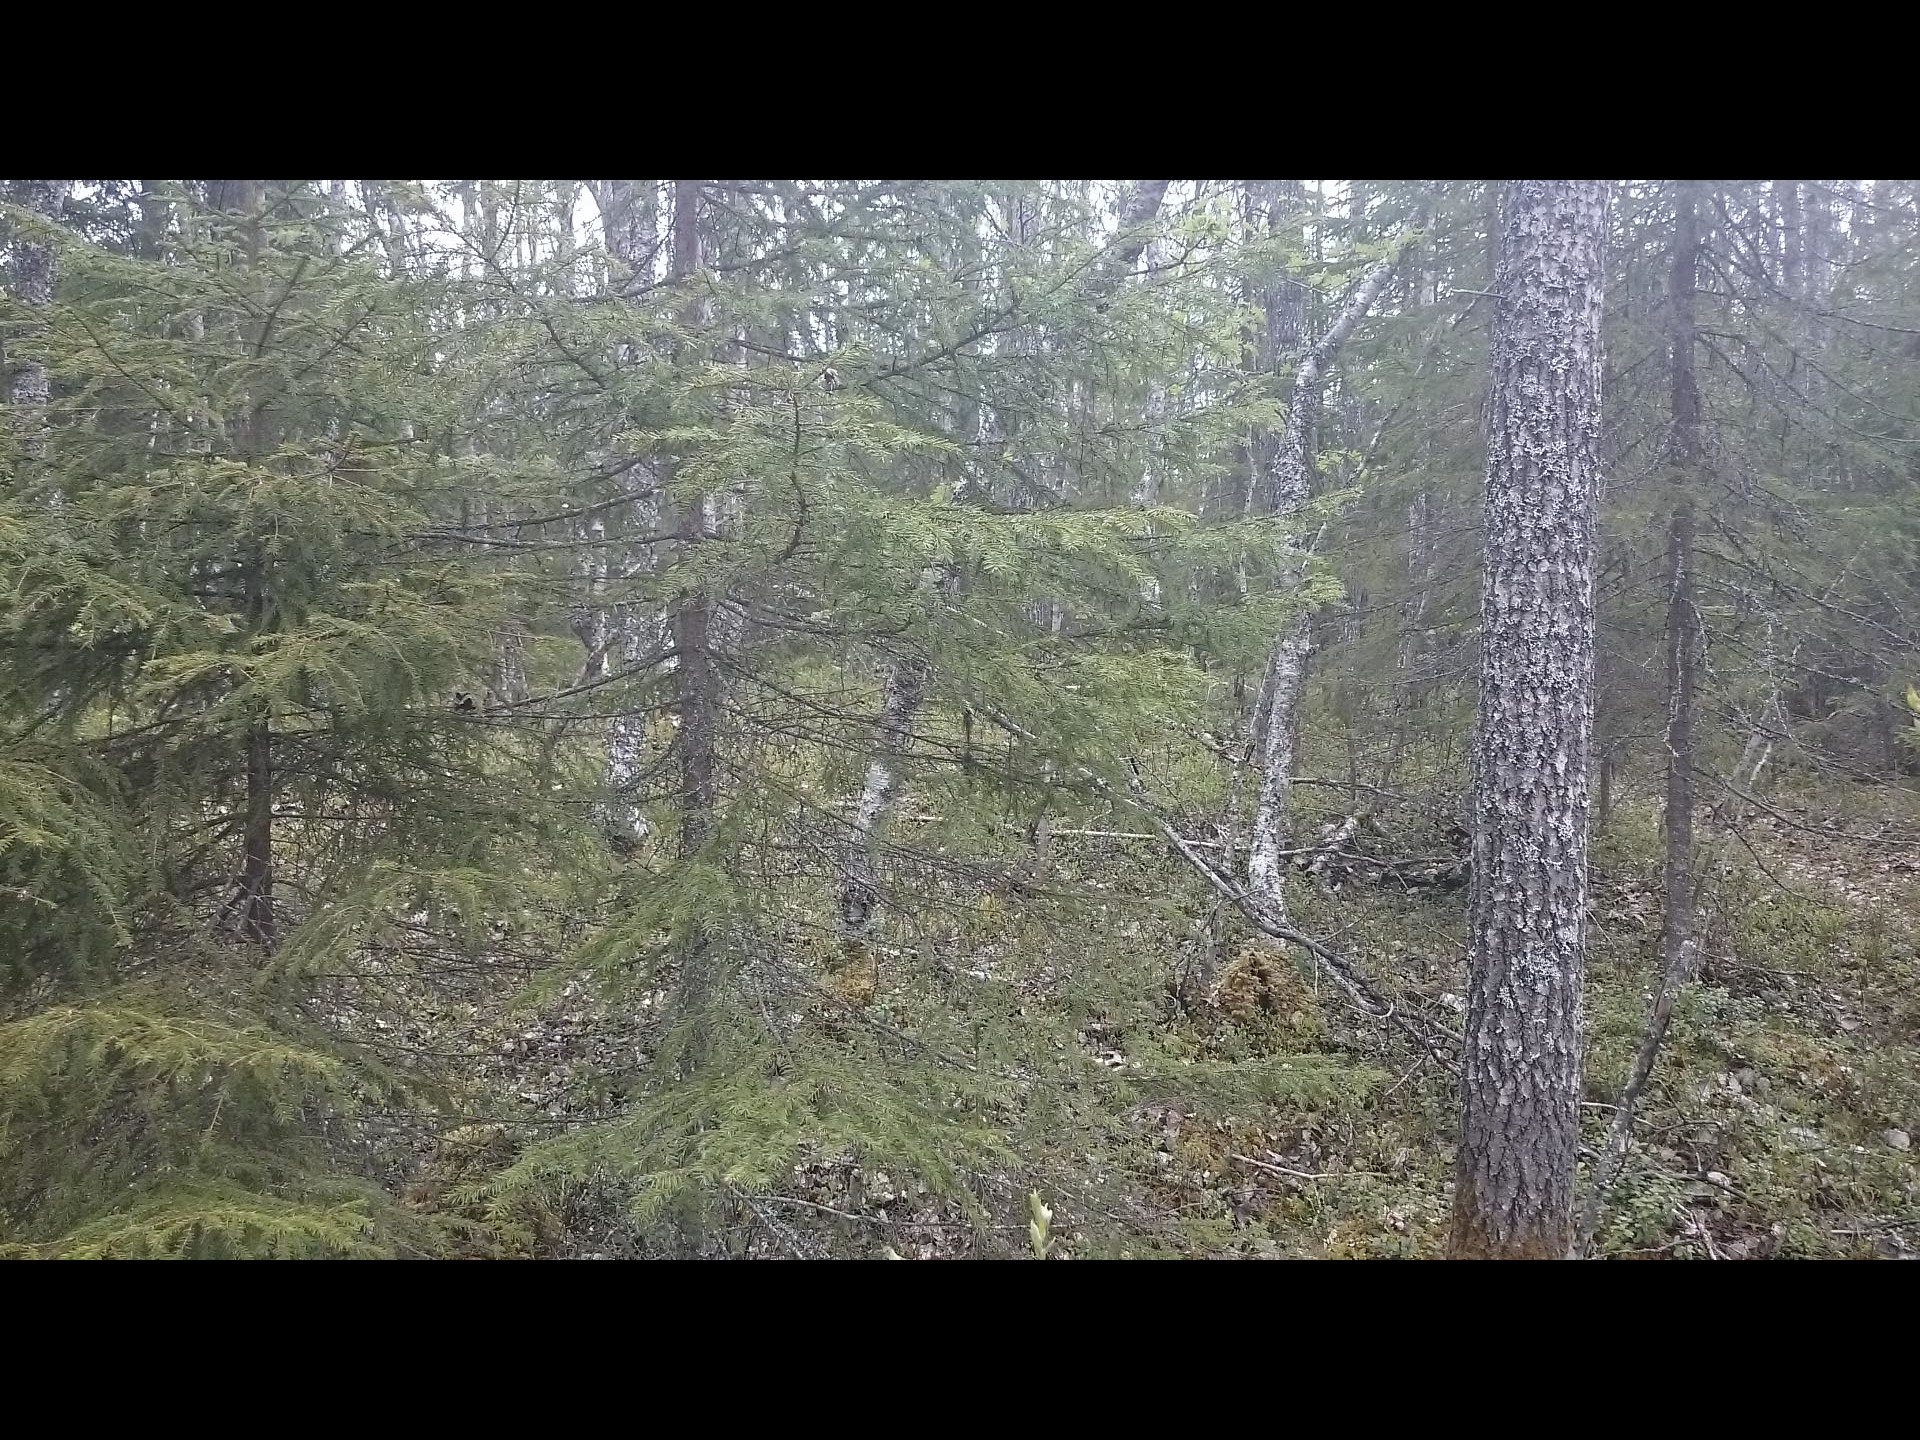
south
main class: Woodland
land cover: Spruce dominated mixed woodland
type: boreal forest
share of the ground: > 75 %
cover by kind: coniferous forest trees 60 %, broadleaved forest trees 20 %, shrubs 15 %, herbaceous plants 5 %
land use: Forestry
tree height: > 5 m
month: June
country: SE
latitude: 63.6469
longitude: 13.8363
